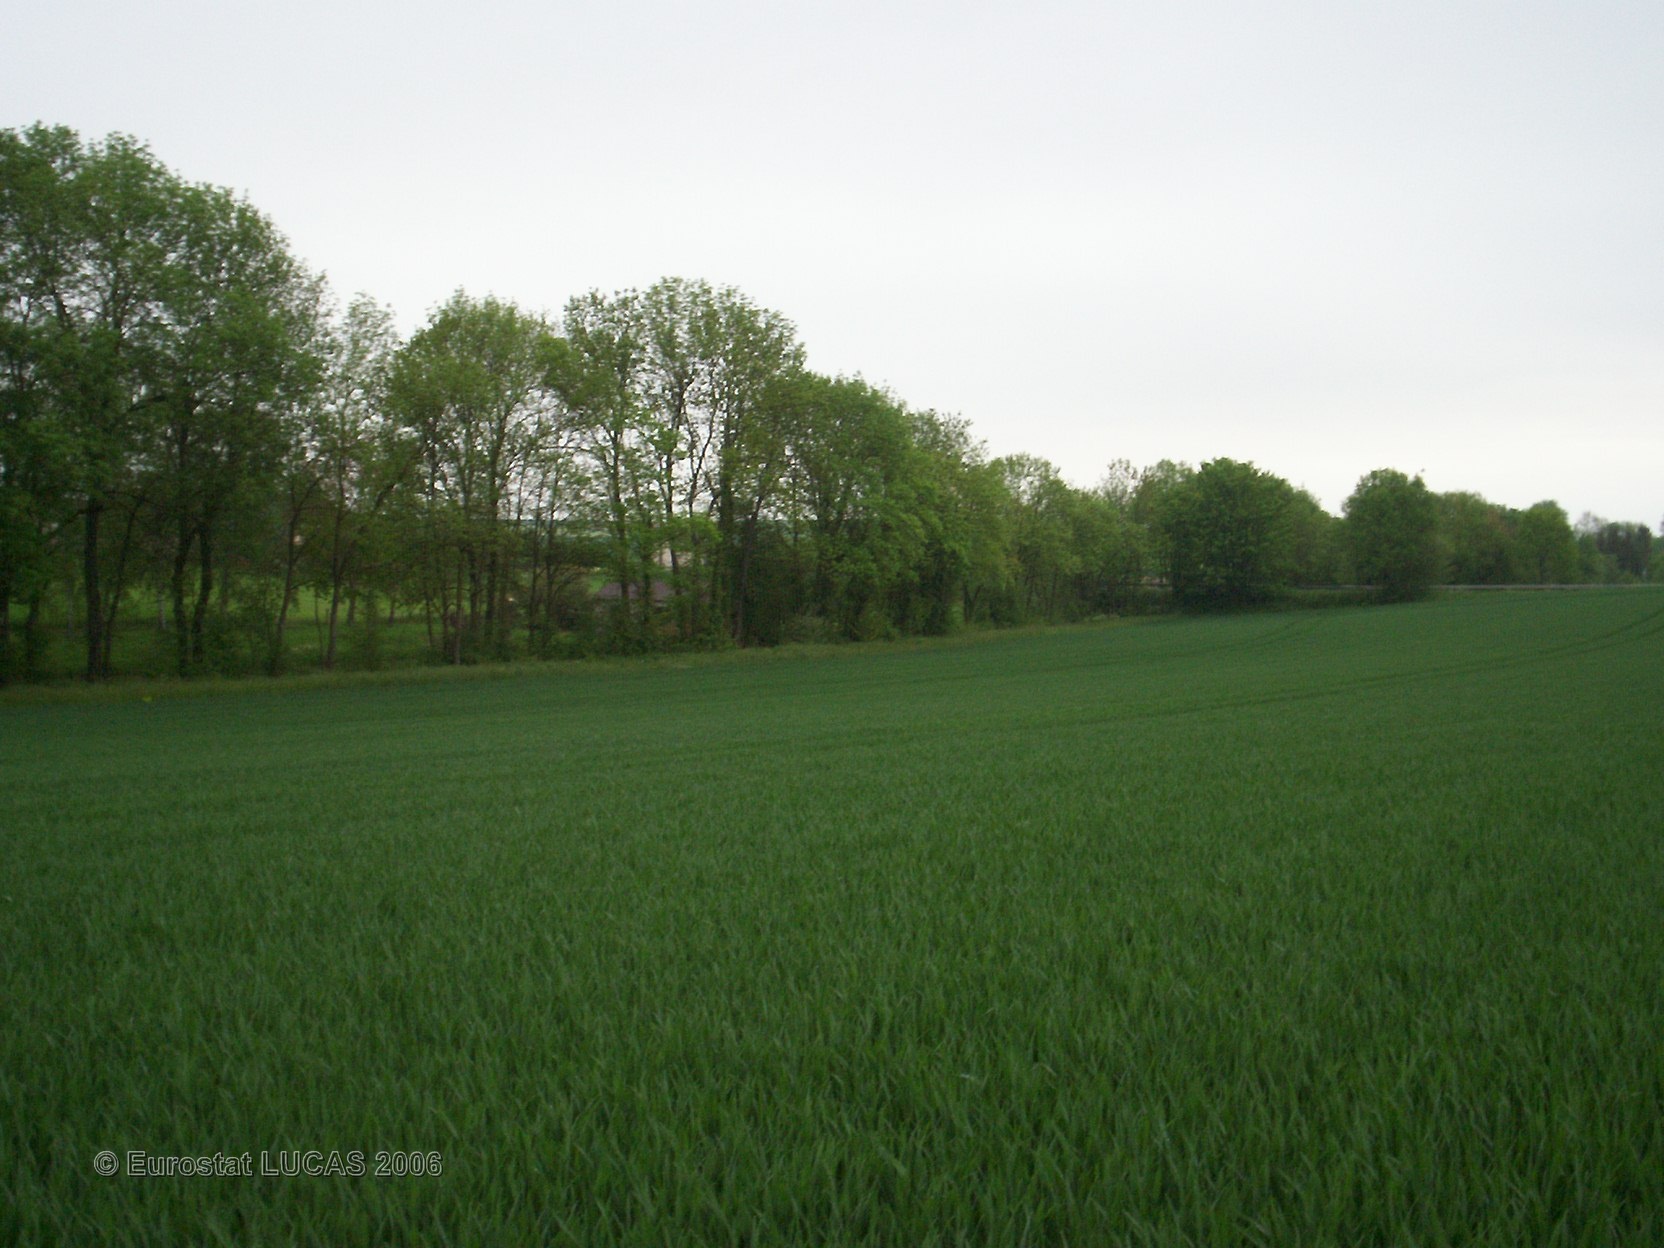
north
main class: Cropland
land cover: Common wheat
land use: Agriculture (excluding fallow land and kitchen gardens)
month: May
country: FR
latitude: 49.5212
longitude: 4.3459
